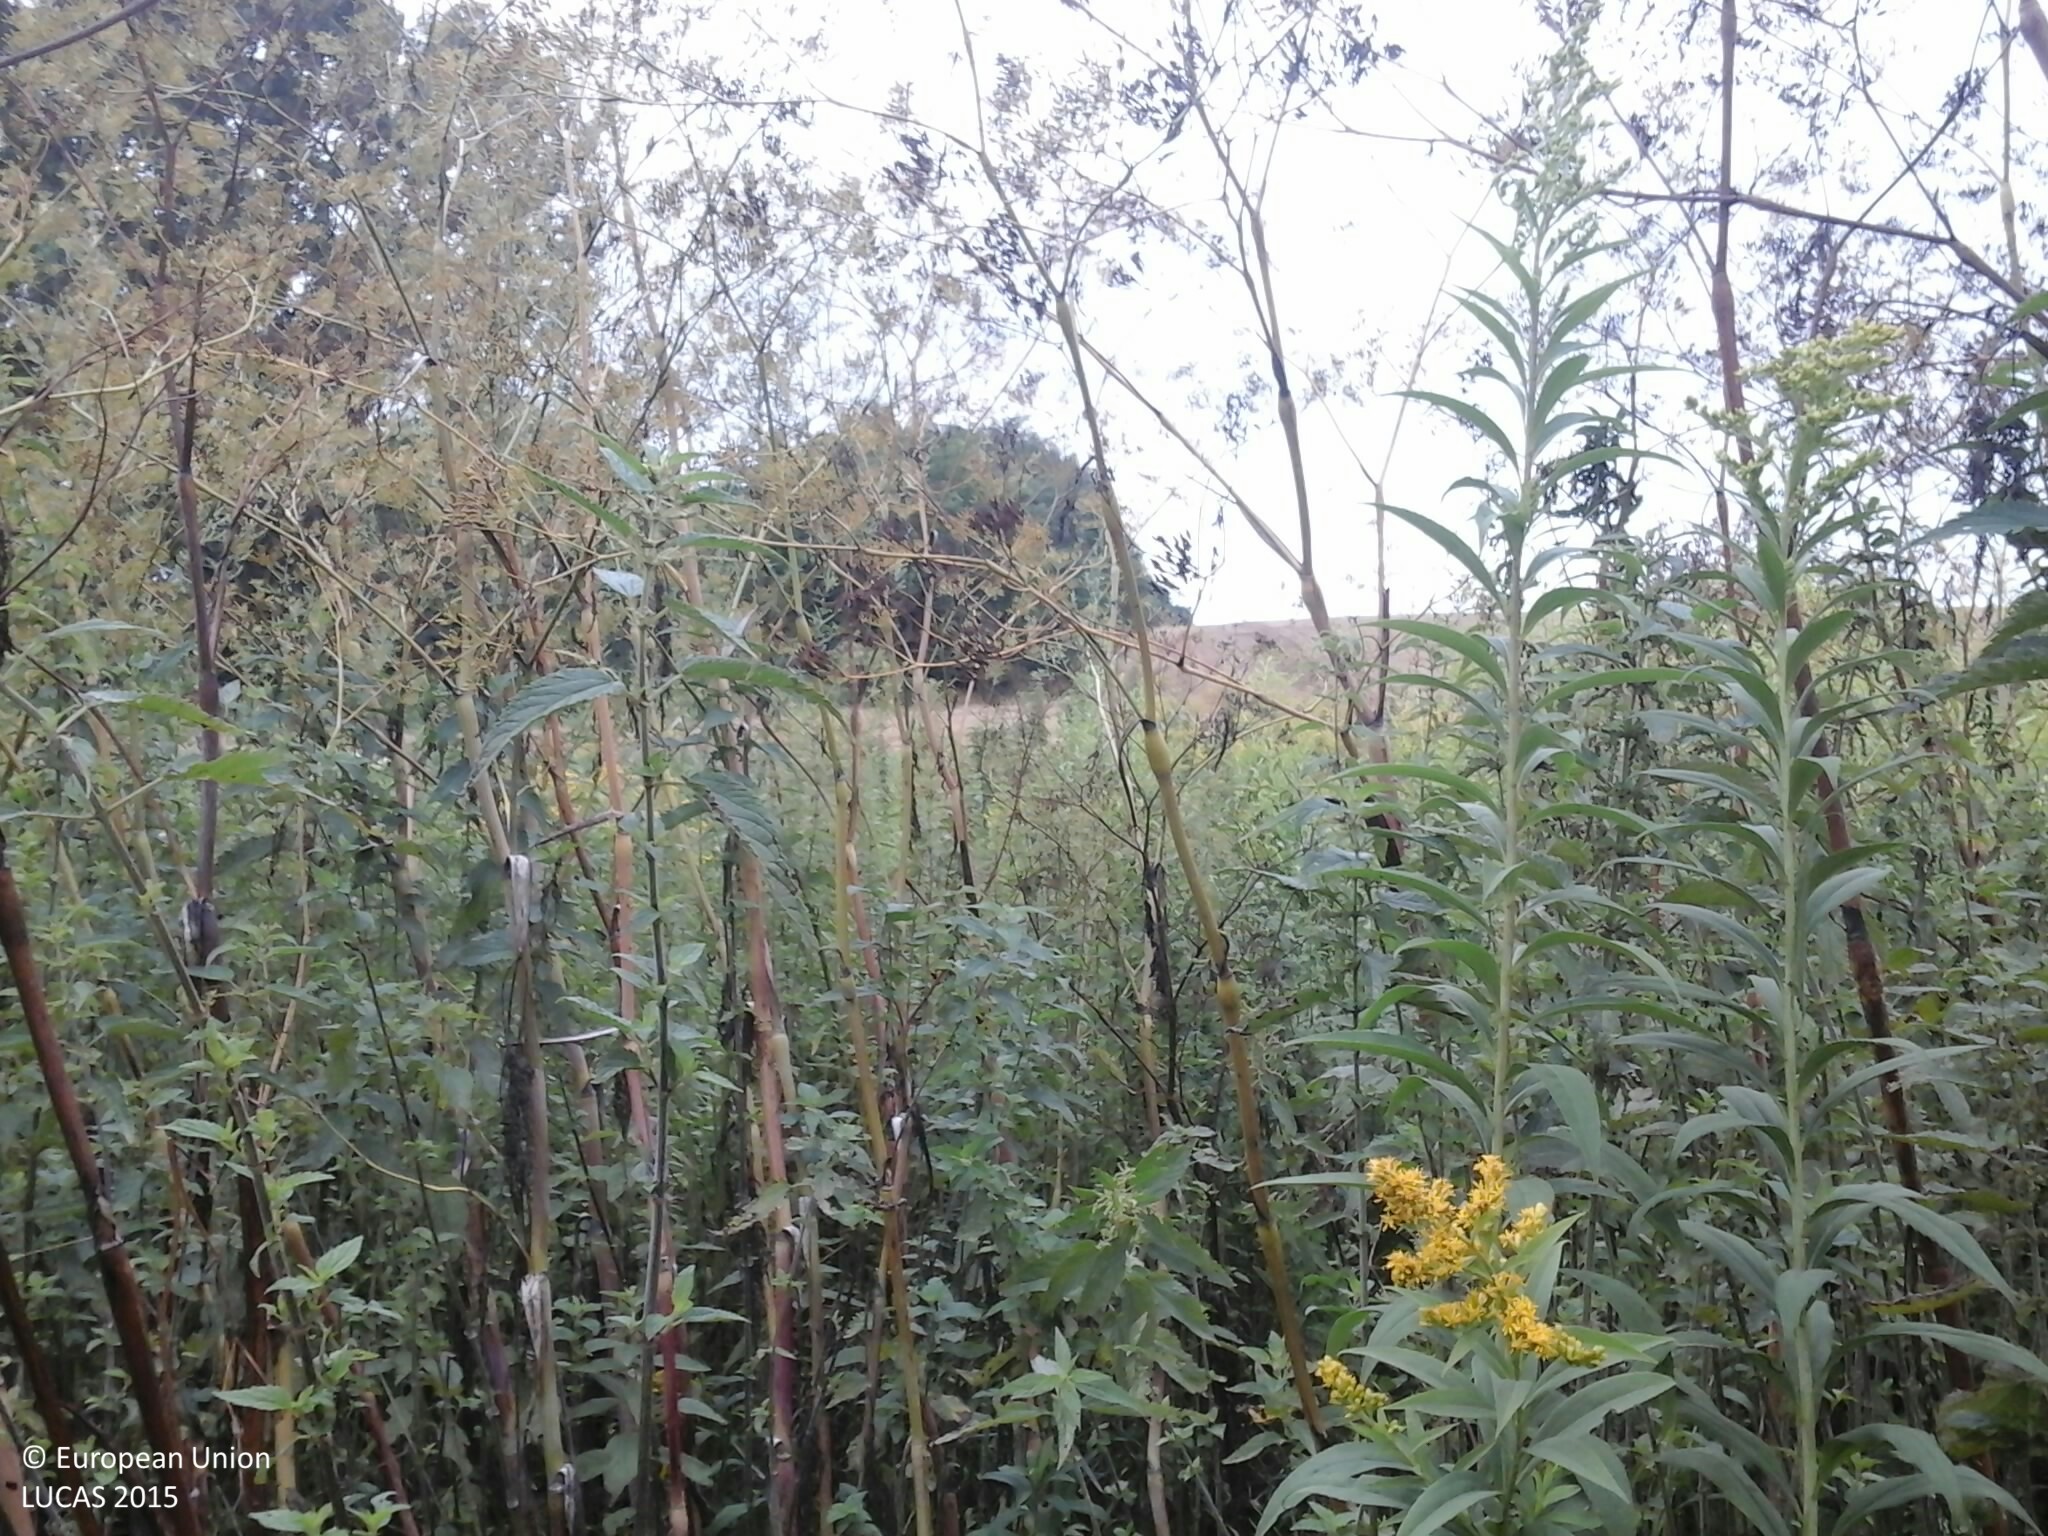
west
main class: Grassland
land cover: Spontaneously vegetated surfaces
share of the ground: > 75 %
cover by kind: herbaceous plants 100 %
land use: Semi-natural and natural areas not in use
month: July
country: HU
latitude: 46.5607
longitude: 17.7156
